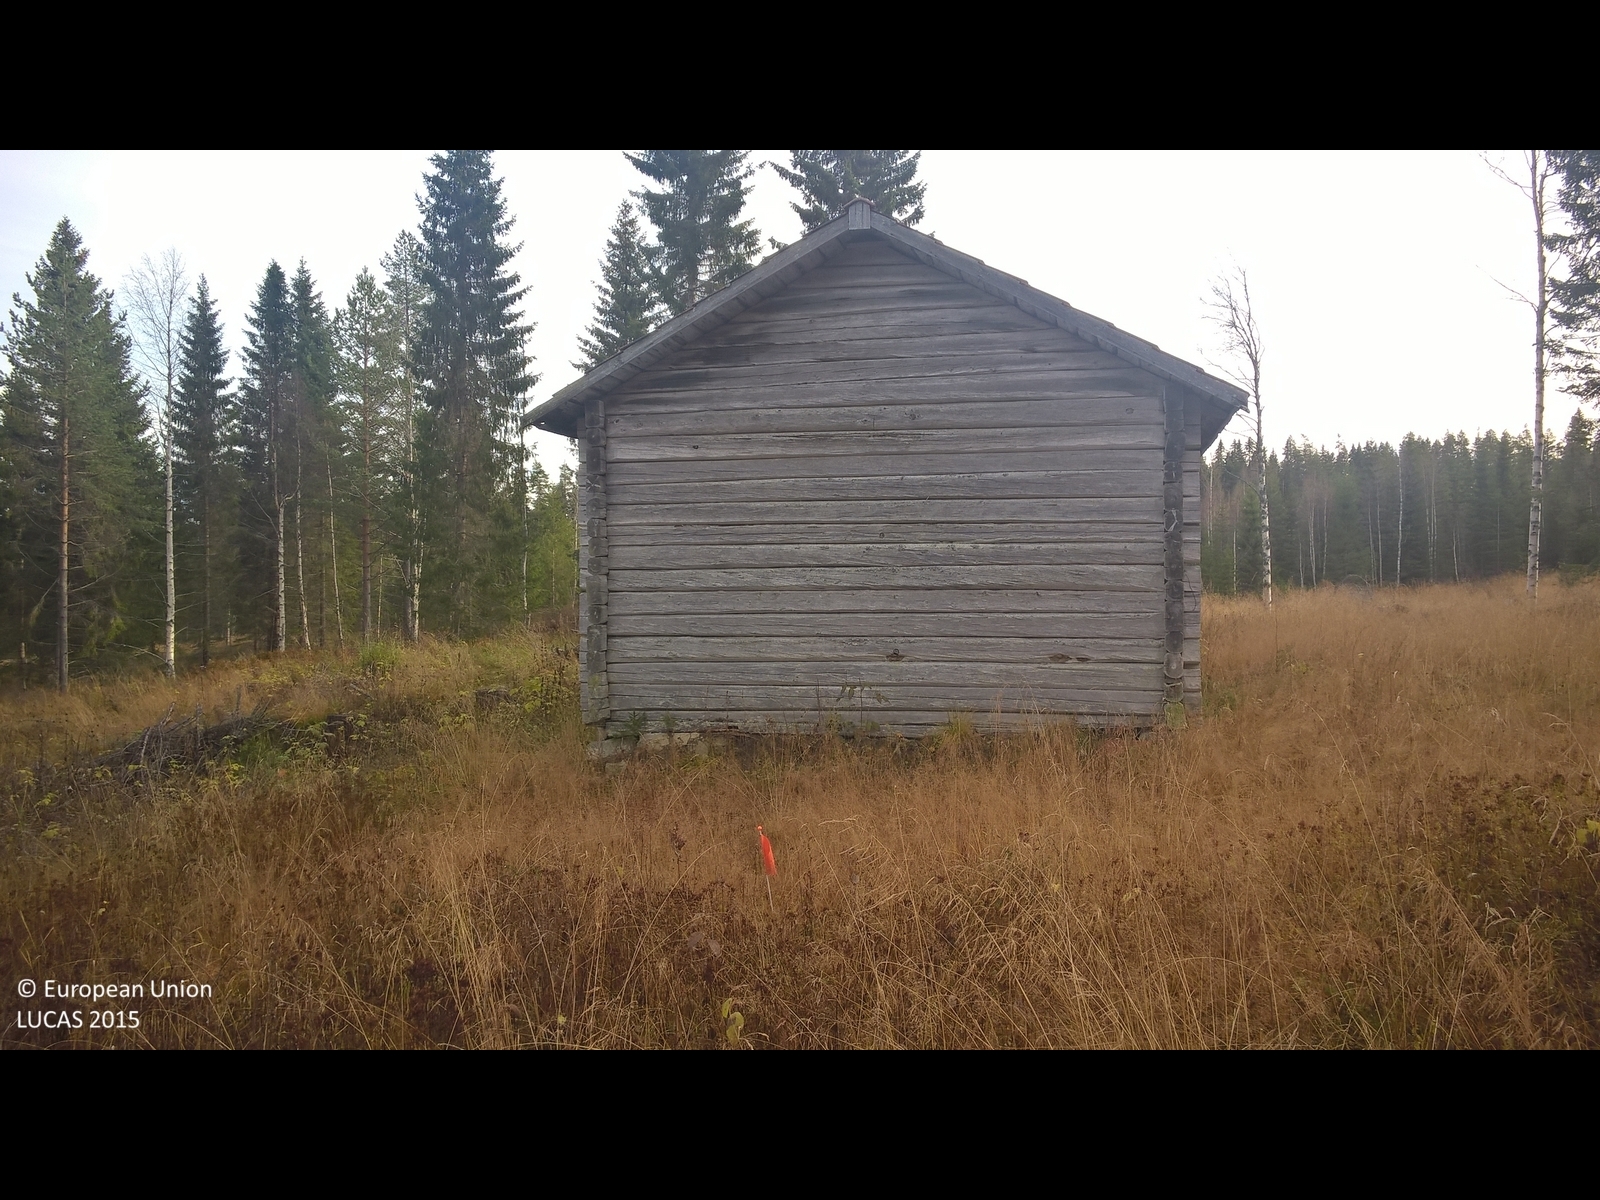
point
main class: Grassland
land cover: Spontaneously vegetated surfaces
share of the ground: > 75 %
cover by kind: herbaceous plants 100 %
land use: Forestry
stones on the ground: < 10 %
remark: Clear cut
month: October
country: SE
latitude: 63.2325
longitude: 15.0524
